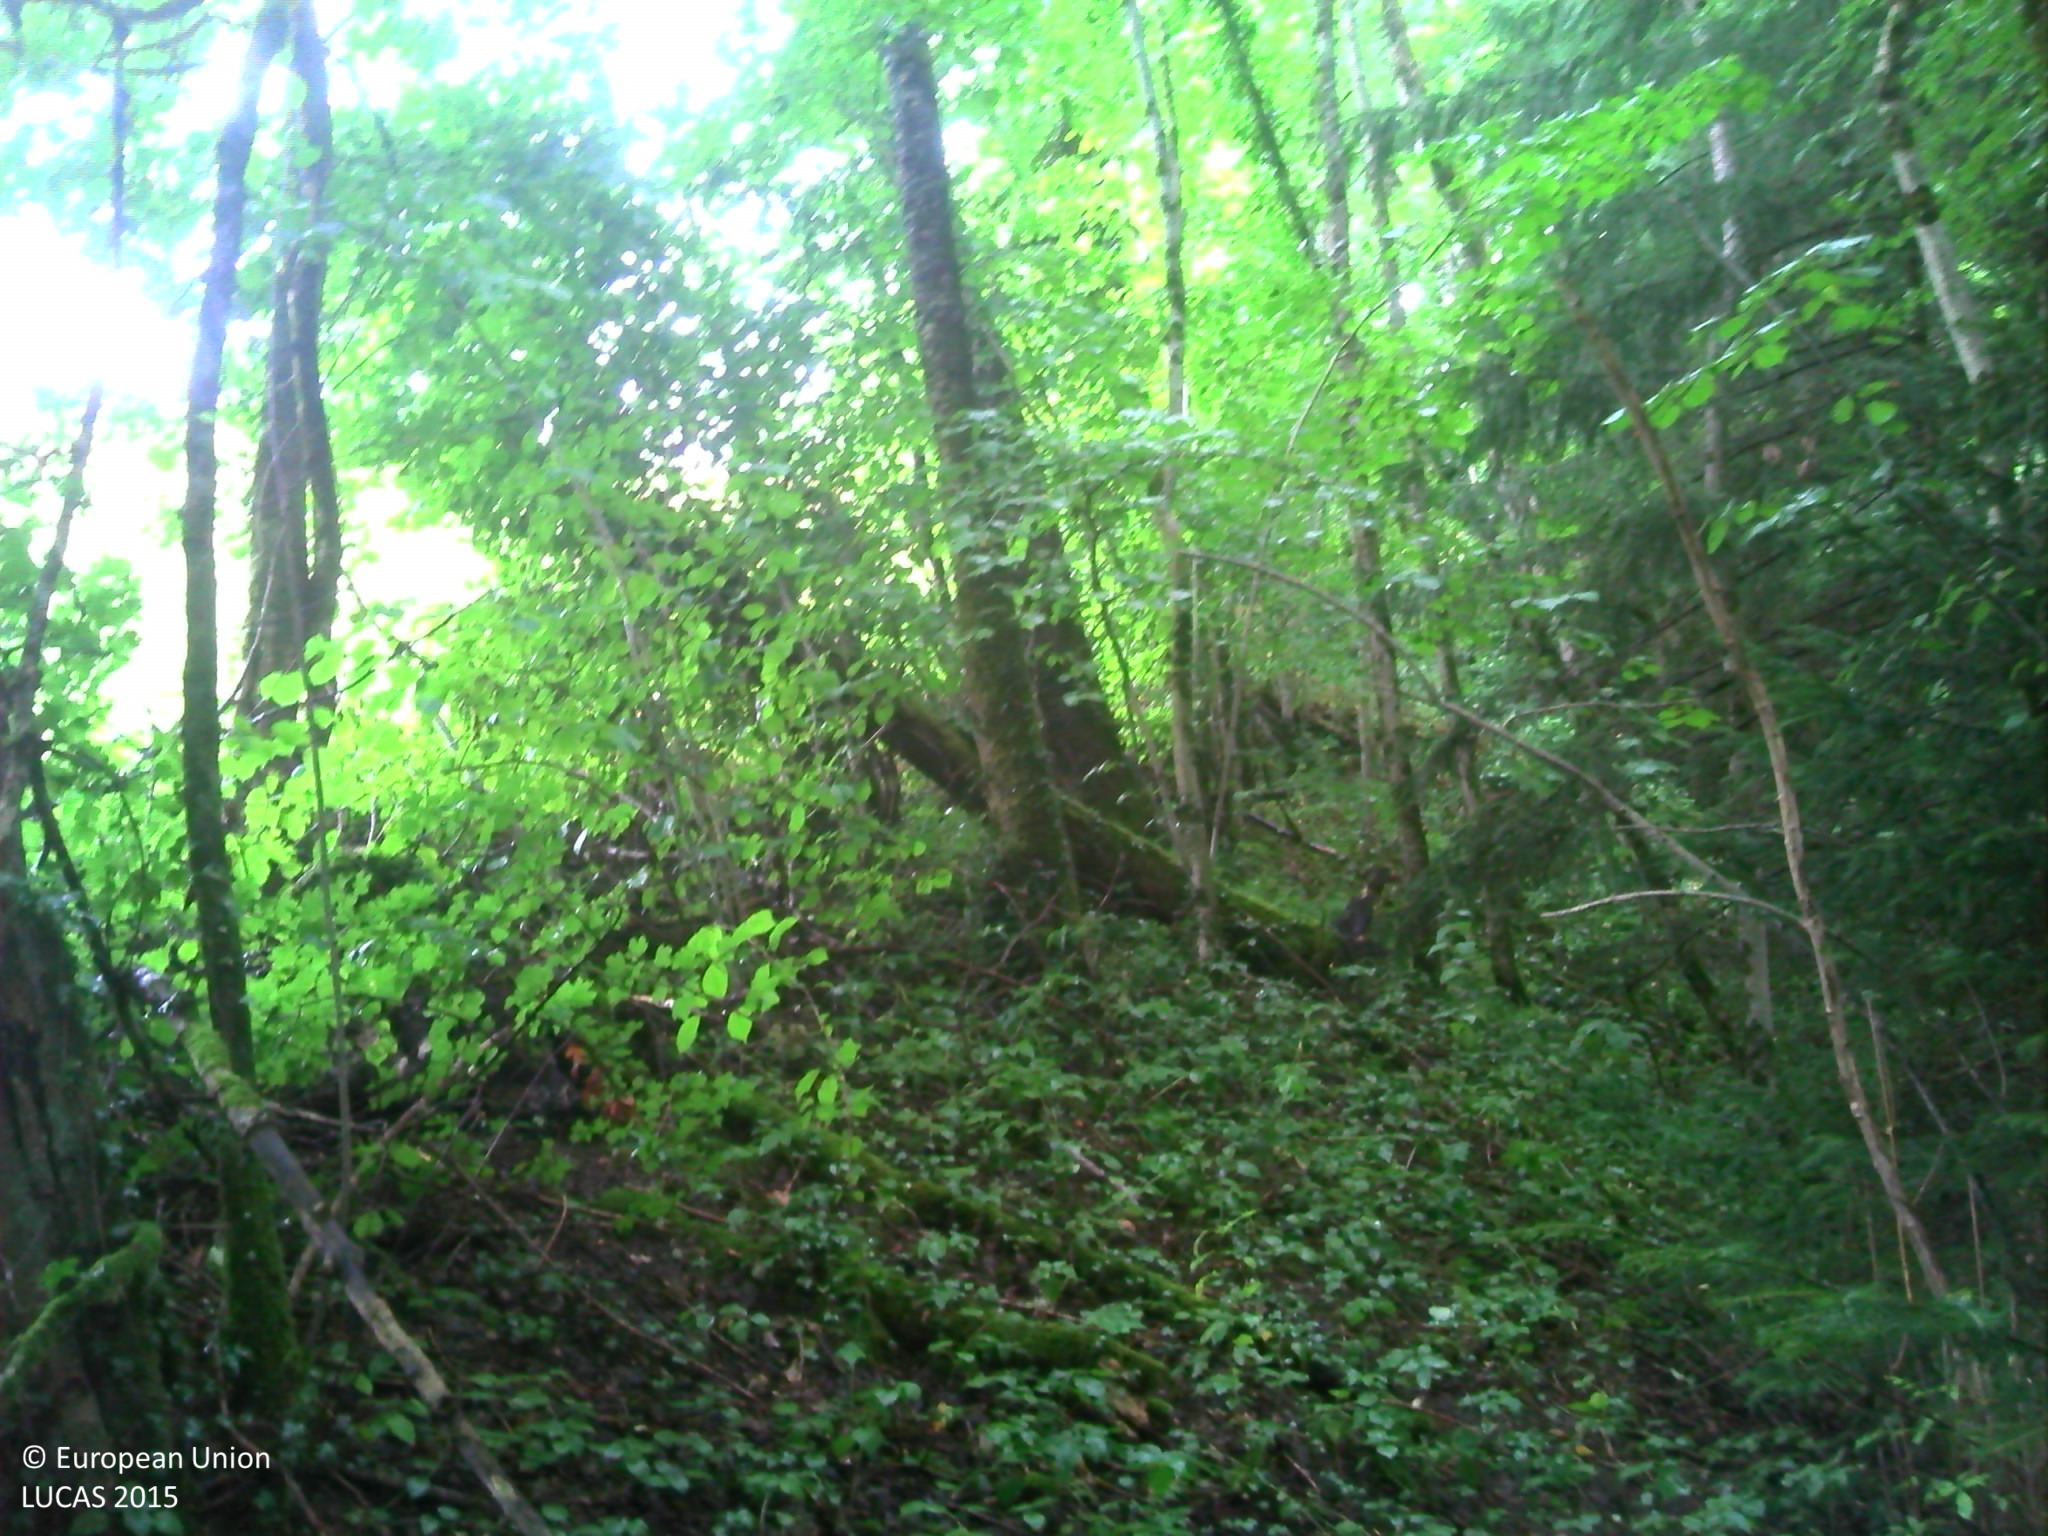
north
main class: Woodland
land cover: Broadleaved woodland
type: beech forest
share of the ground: > 75 %
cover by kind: broadleaved forest trees 65 %, coniferous forest trees 15 %, herbaceous plants 15 %, lichens and mosses 5 %
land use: Semi-natural and natural areas not in use
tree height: > 5 m
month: July
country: FR
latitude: 45.9770
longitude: 6.1963
